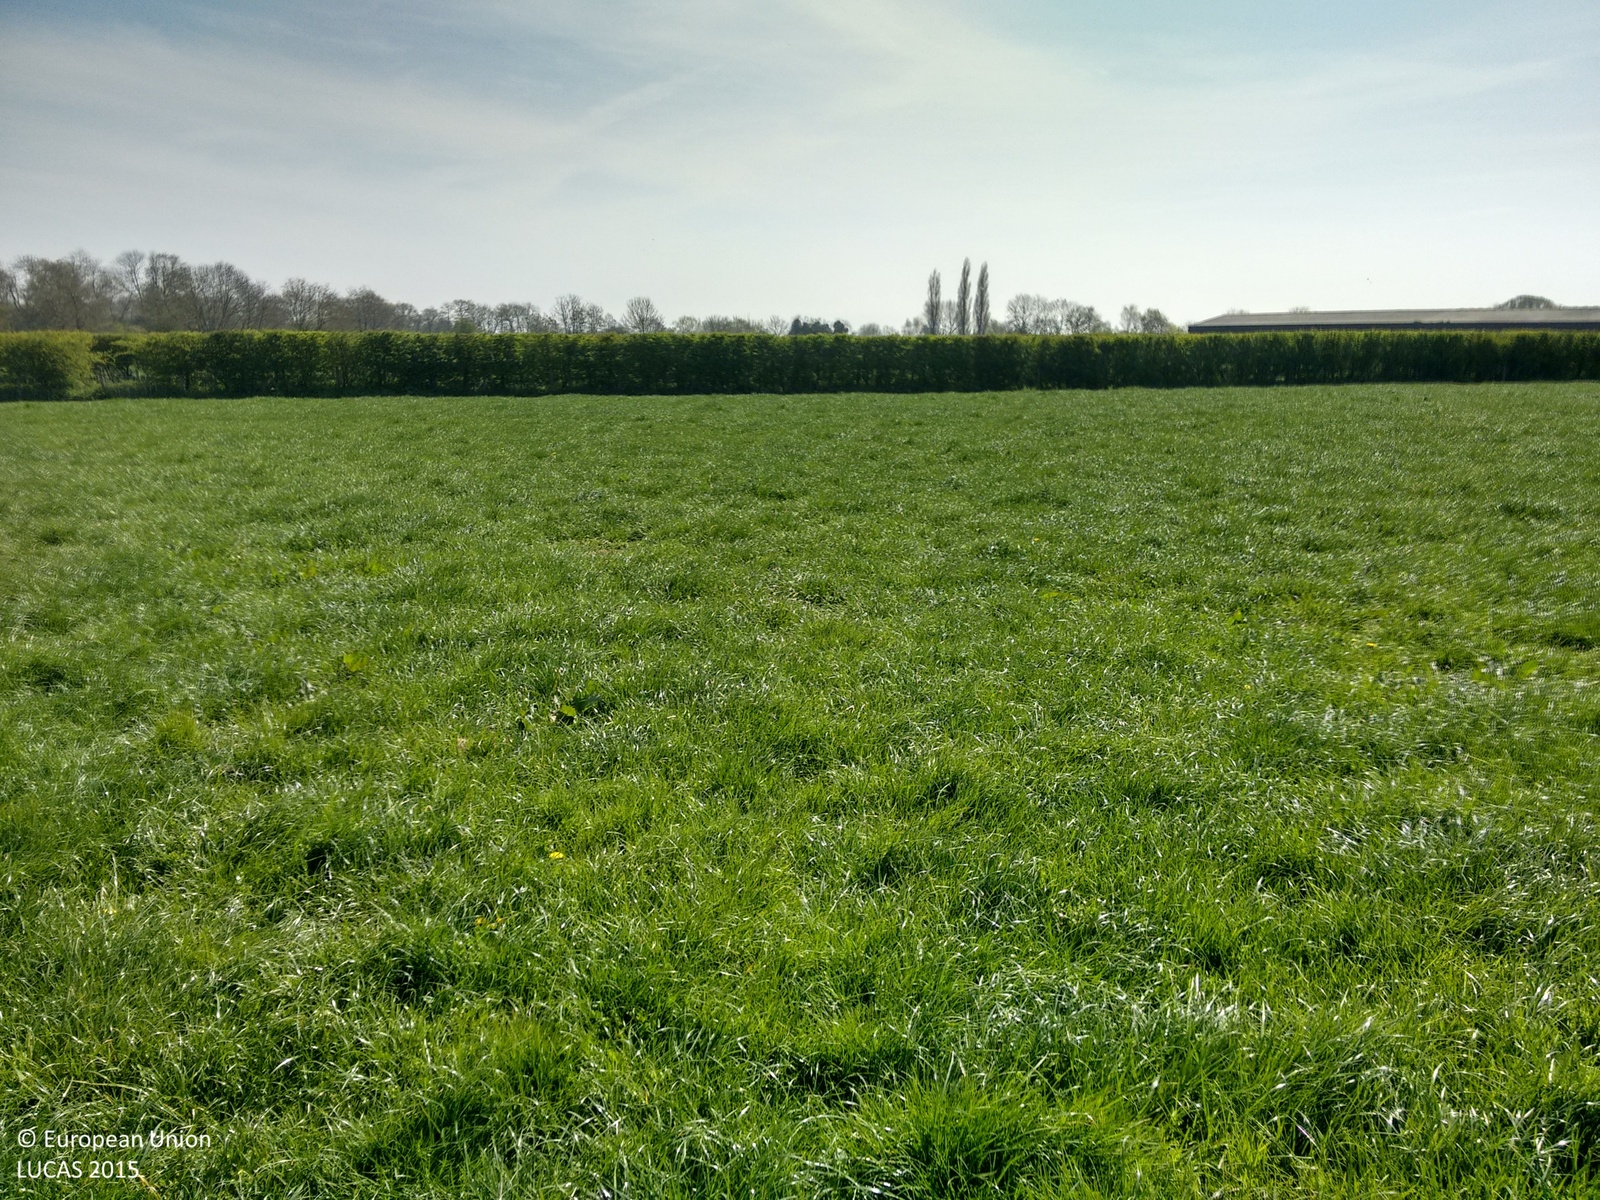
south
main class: Grassland
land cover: Grassland without tree/shrub cover
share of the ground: > 75 %
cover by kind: herbaceous plants 100 %
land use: Agriculture (excluding fallow land and kitchen gardens)
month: April
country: GB
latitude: 51.2216
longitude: 0.3344
